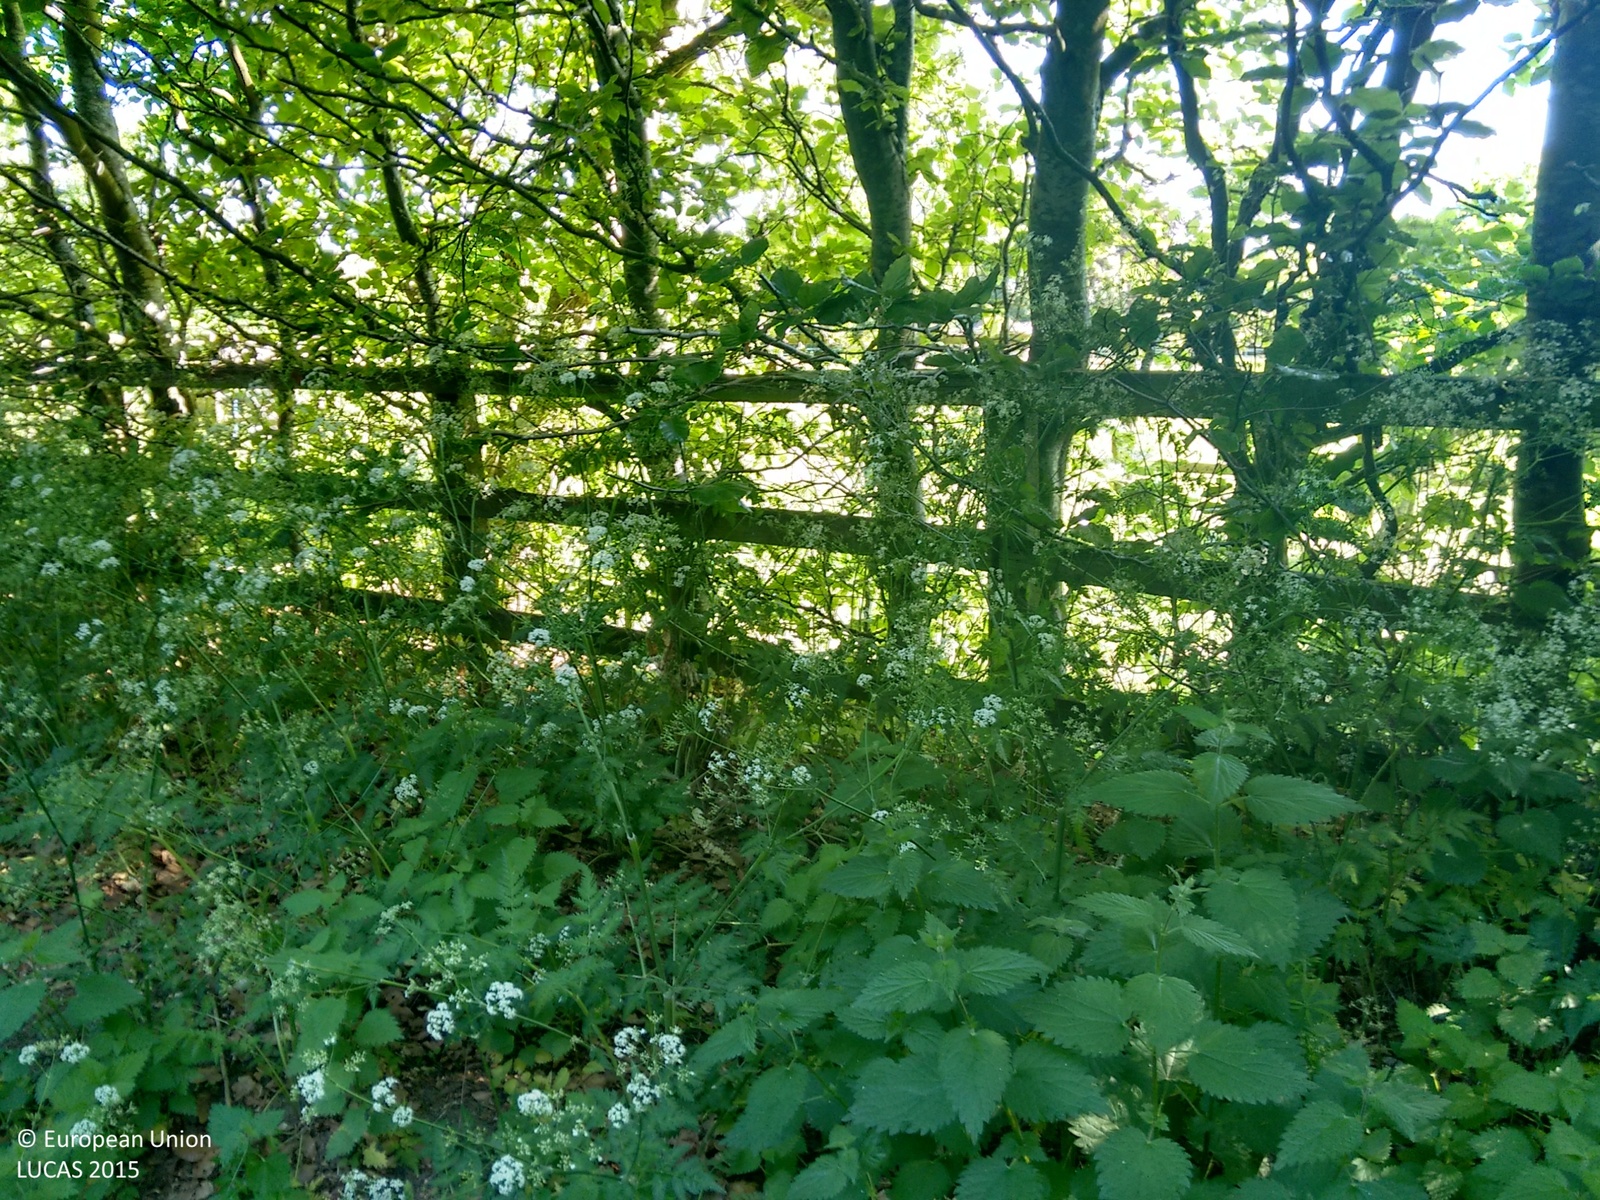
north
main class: Woodland
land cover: Broadleaved woodland
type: mesophytic deciduous forest
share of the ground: > 75 %
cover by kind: broadleaved forest trees 95 %, shrubs 5 %
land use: Forestry
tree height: > 5 m
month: June
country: GB
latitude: 51.9676
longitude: -1.6244
